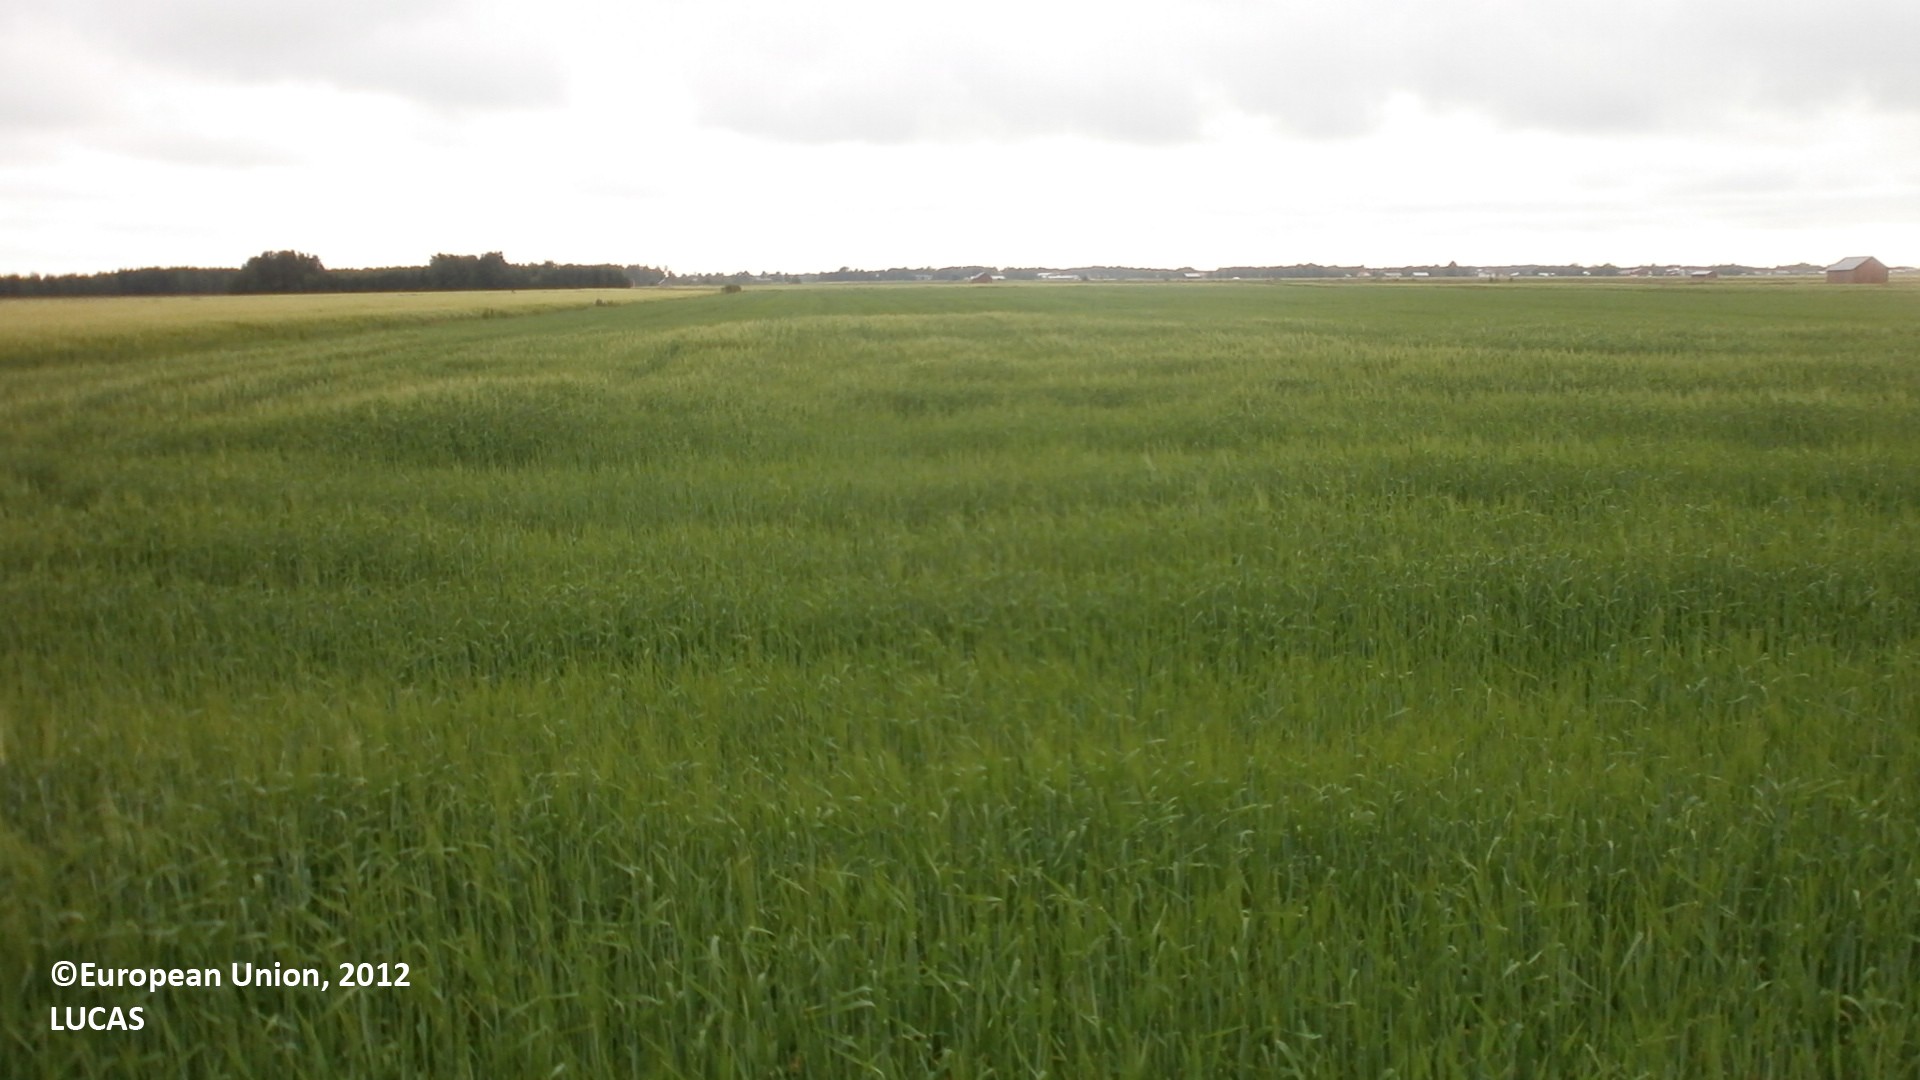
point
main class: Cropland
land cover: Barley
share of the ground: > 75 %
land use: Agriculture (excluding fallow land and kitchen gardens)
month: July
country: FI
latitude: 64.2282
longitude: 24.0610
